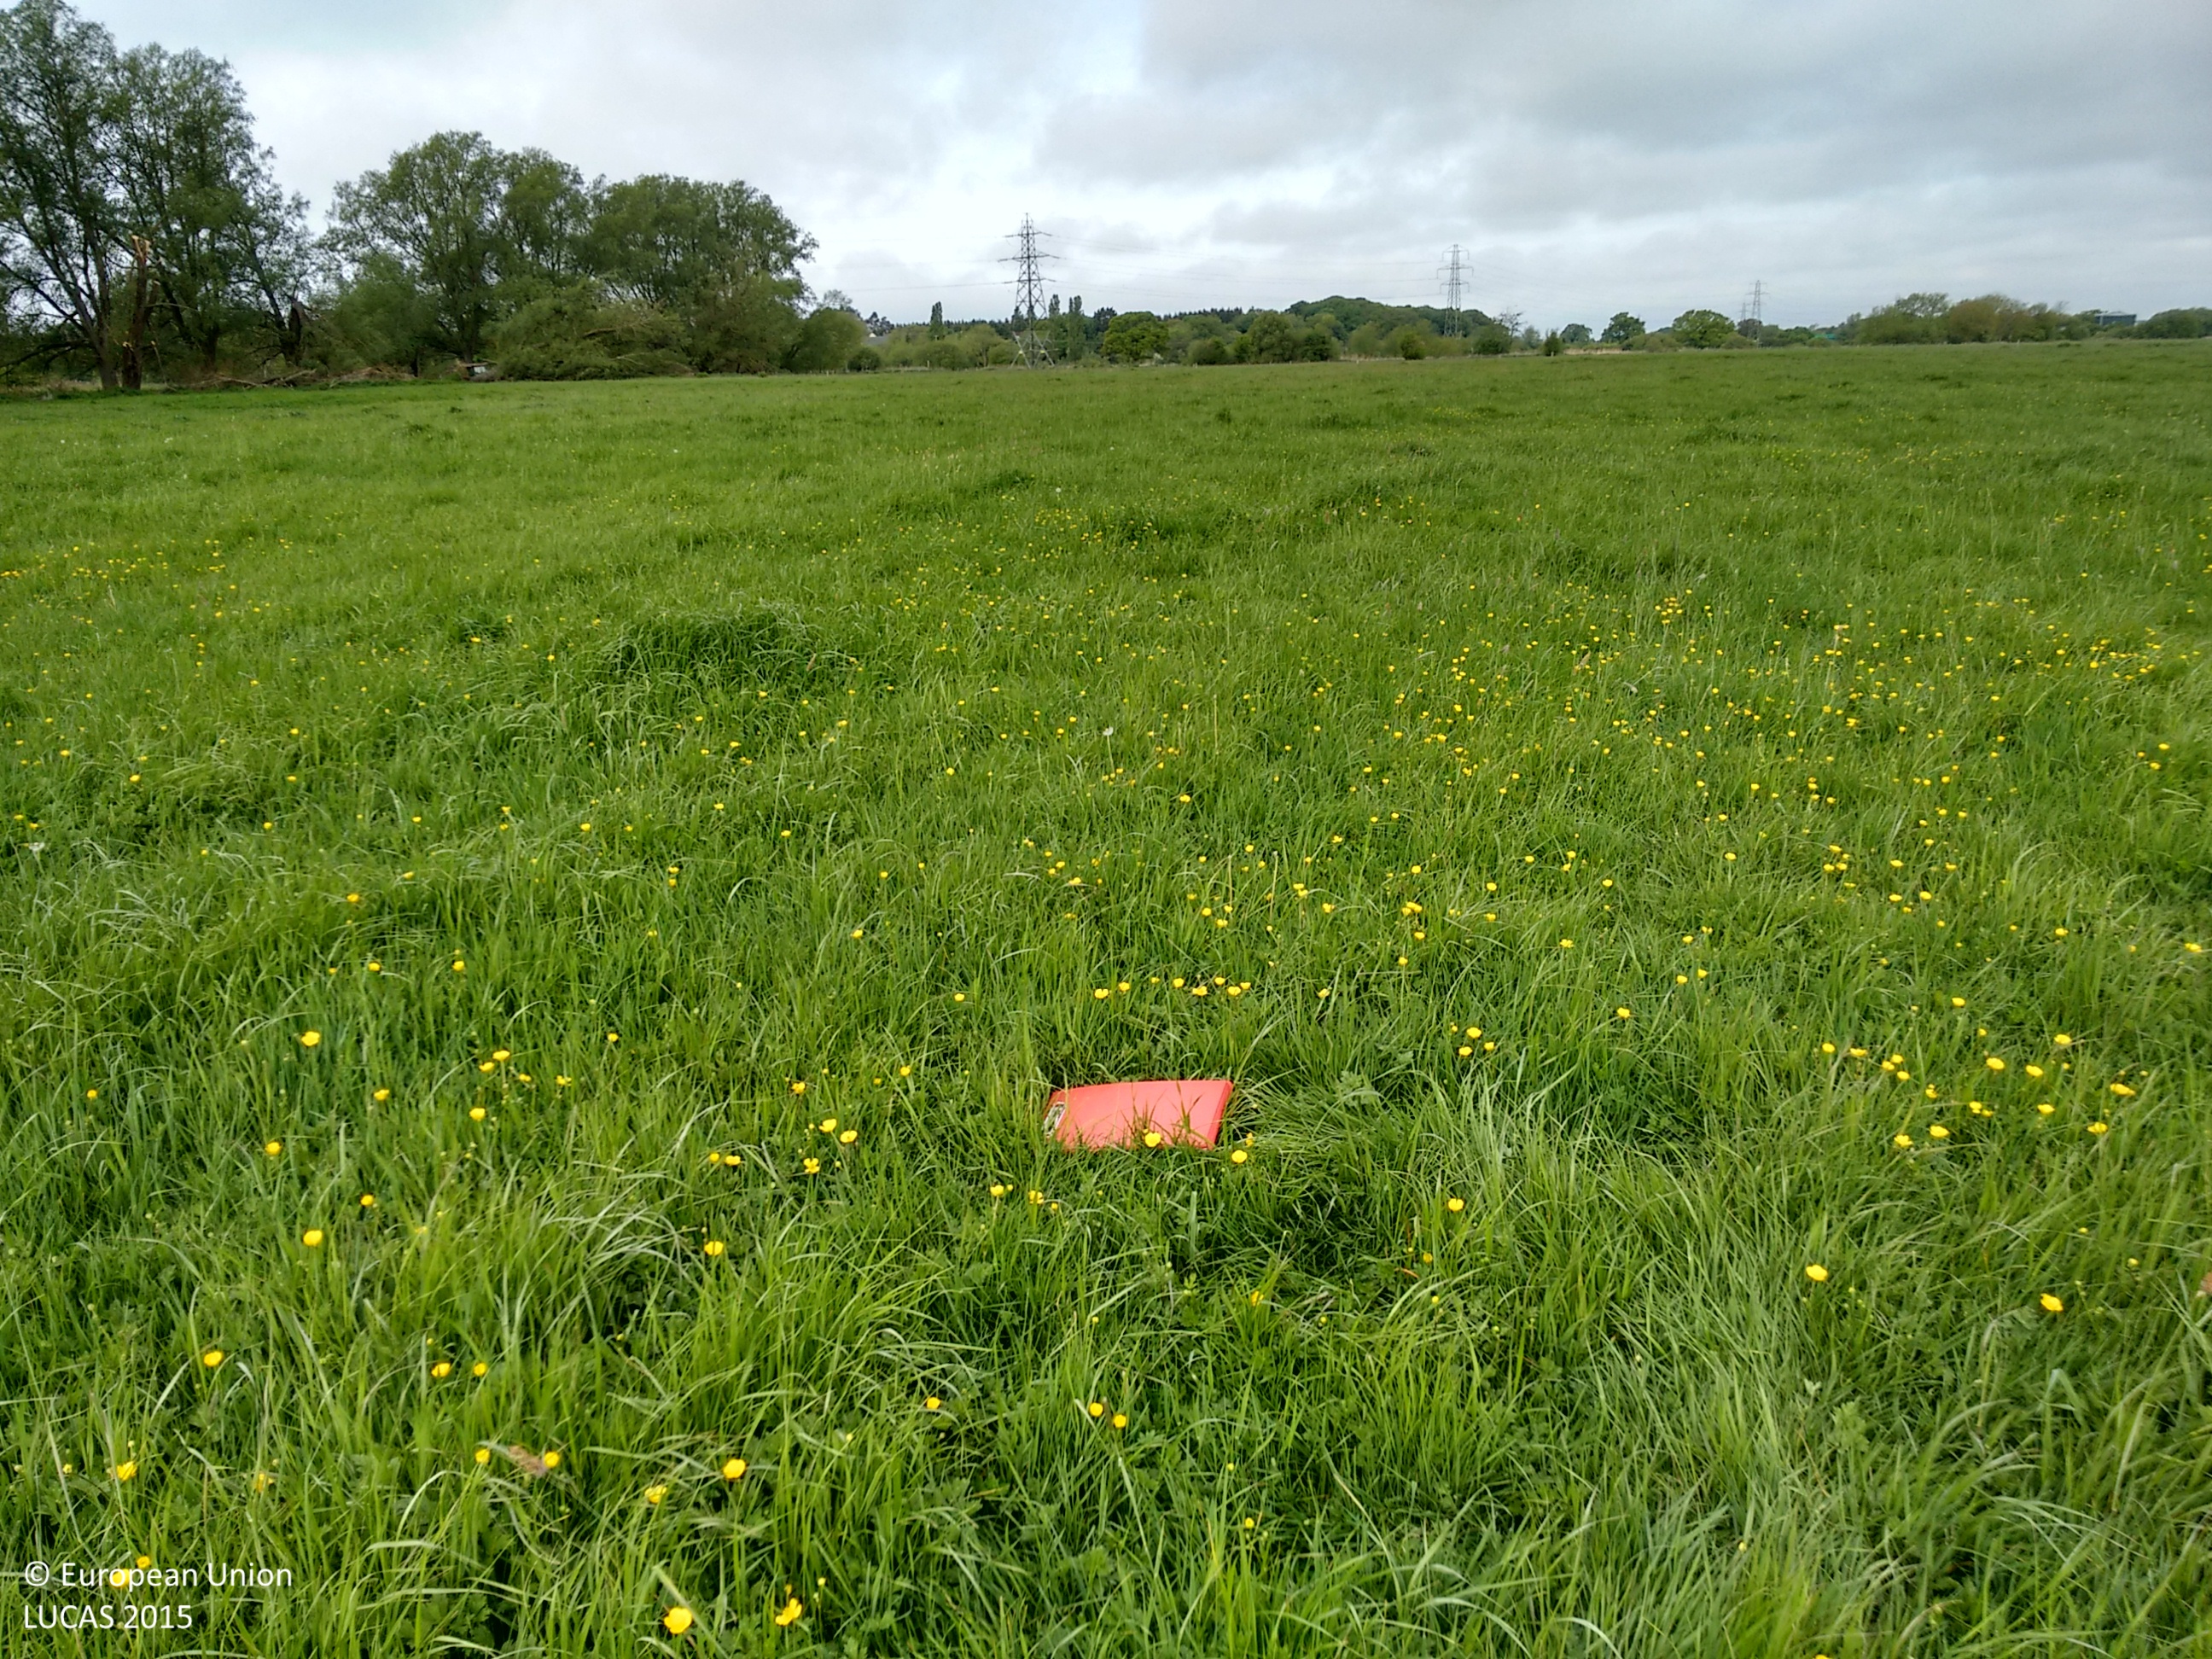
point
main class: Grassland
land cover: Grassland without tree/shrub cover
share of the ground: > 75 %
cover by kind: herbaceous plants 100 %
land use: Agriculture (excluding fallow land and kitchen gardens)
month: May
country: GB
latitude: 50.7647
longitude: -1.8376
